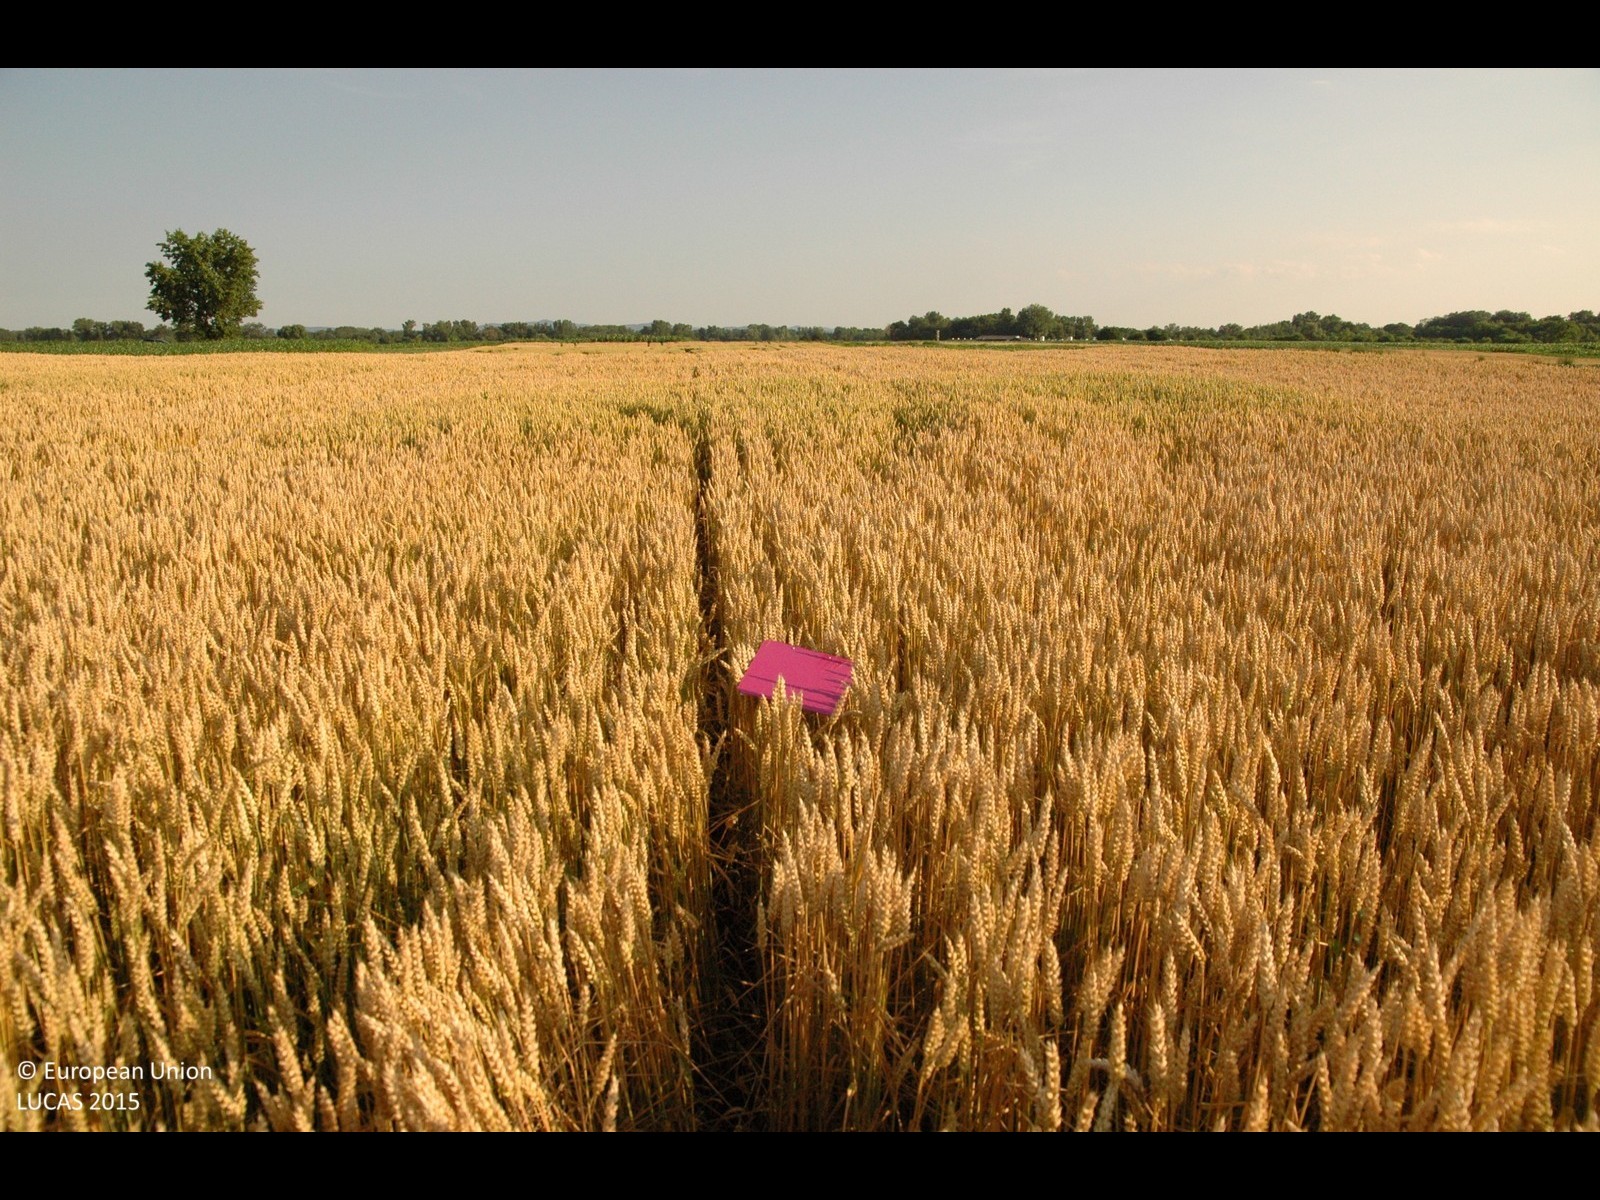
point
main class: Cropland
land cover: Common wheat
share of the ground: > 75 %
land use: Agriculture (excluding fallow land and kitchen gardens)
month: June
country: HR
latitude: 46.3367
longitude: 16.4573
